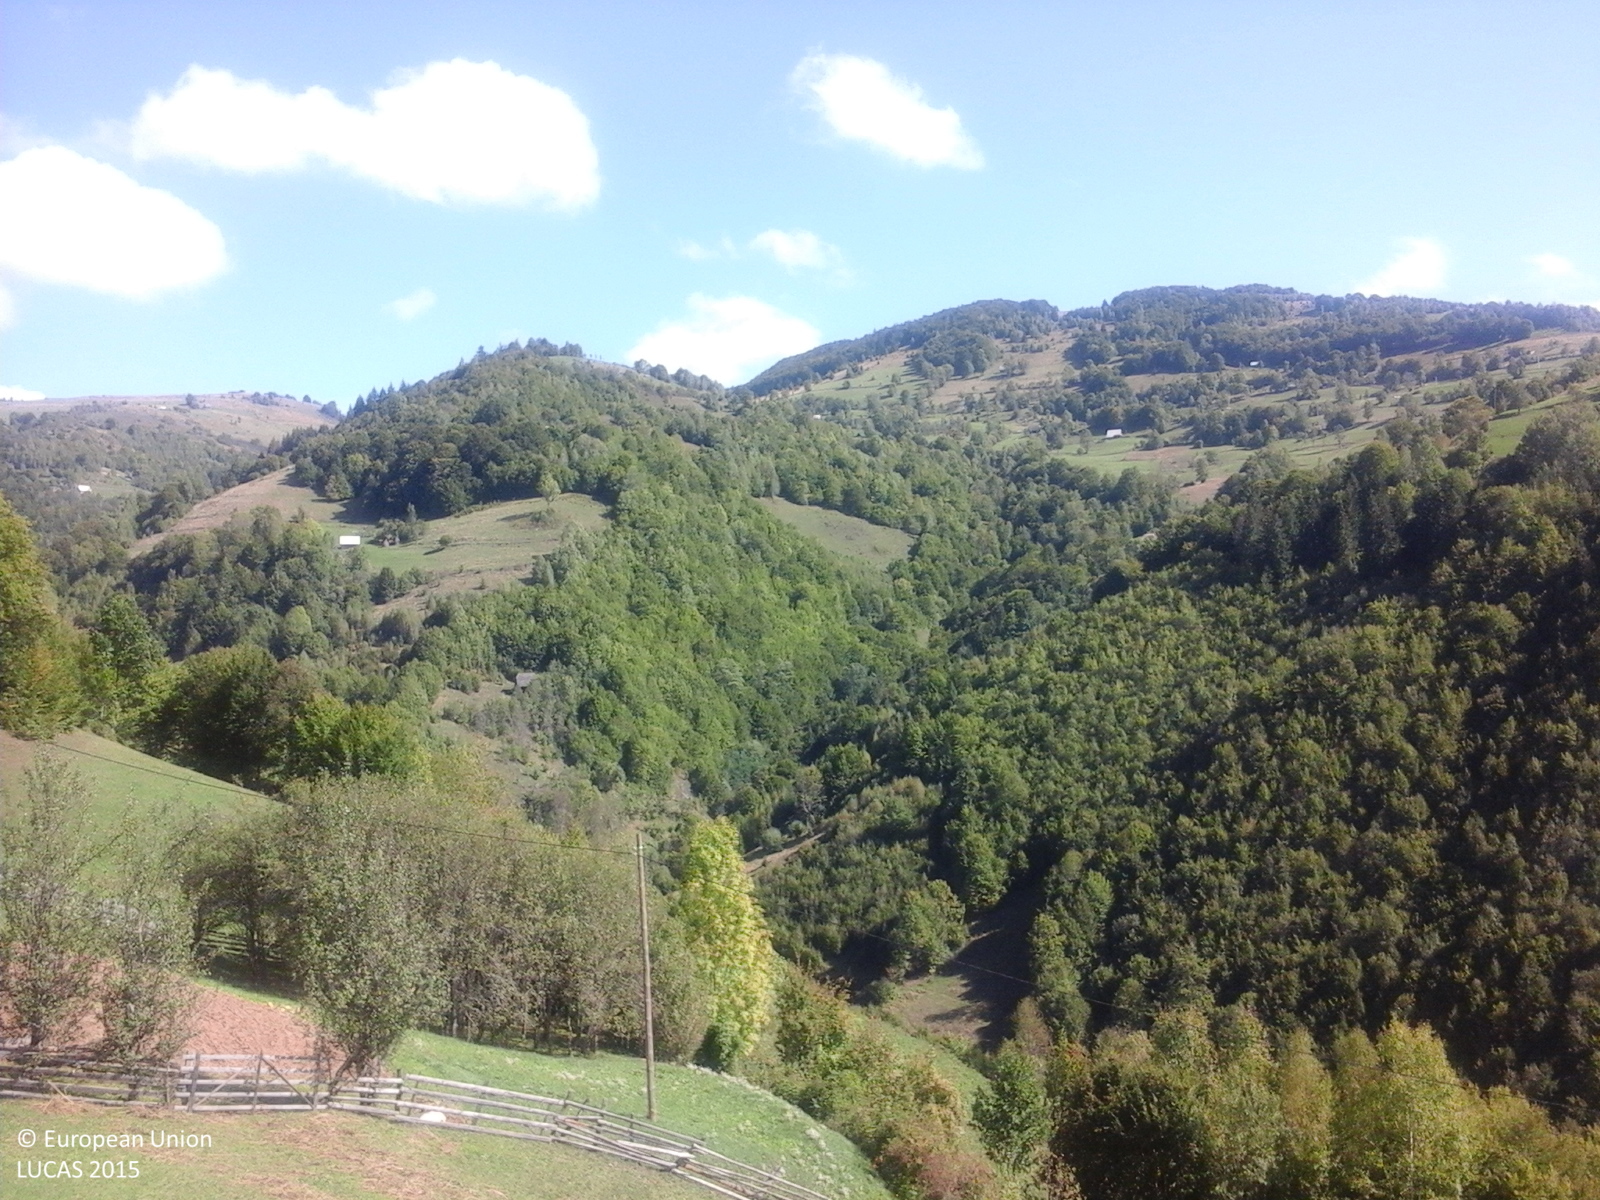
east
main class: Grassland
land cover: Grassland without tree/shrub cover
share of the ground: > 75 %
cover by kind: herbaceous plants 100 %
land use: Agriculture (excluding fallow land and kitchen gardens)
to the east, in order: Grassland without tree/shrub cover; Electric lines; Grassland without tree/shrub cover; Fences; Grassland without tree/shrub cover; Grassland with sparse tree/shrub cover; Broadleaved woodland
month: October
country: RO
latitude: 46.3947
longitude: 23.1310
